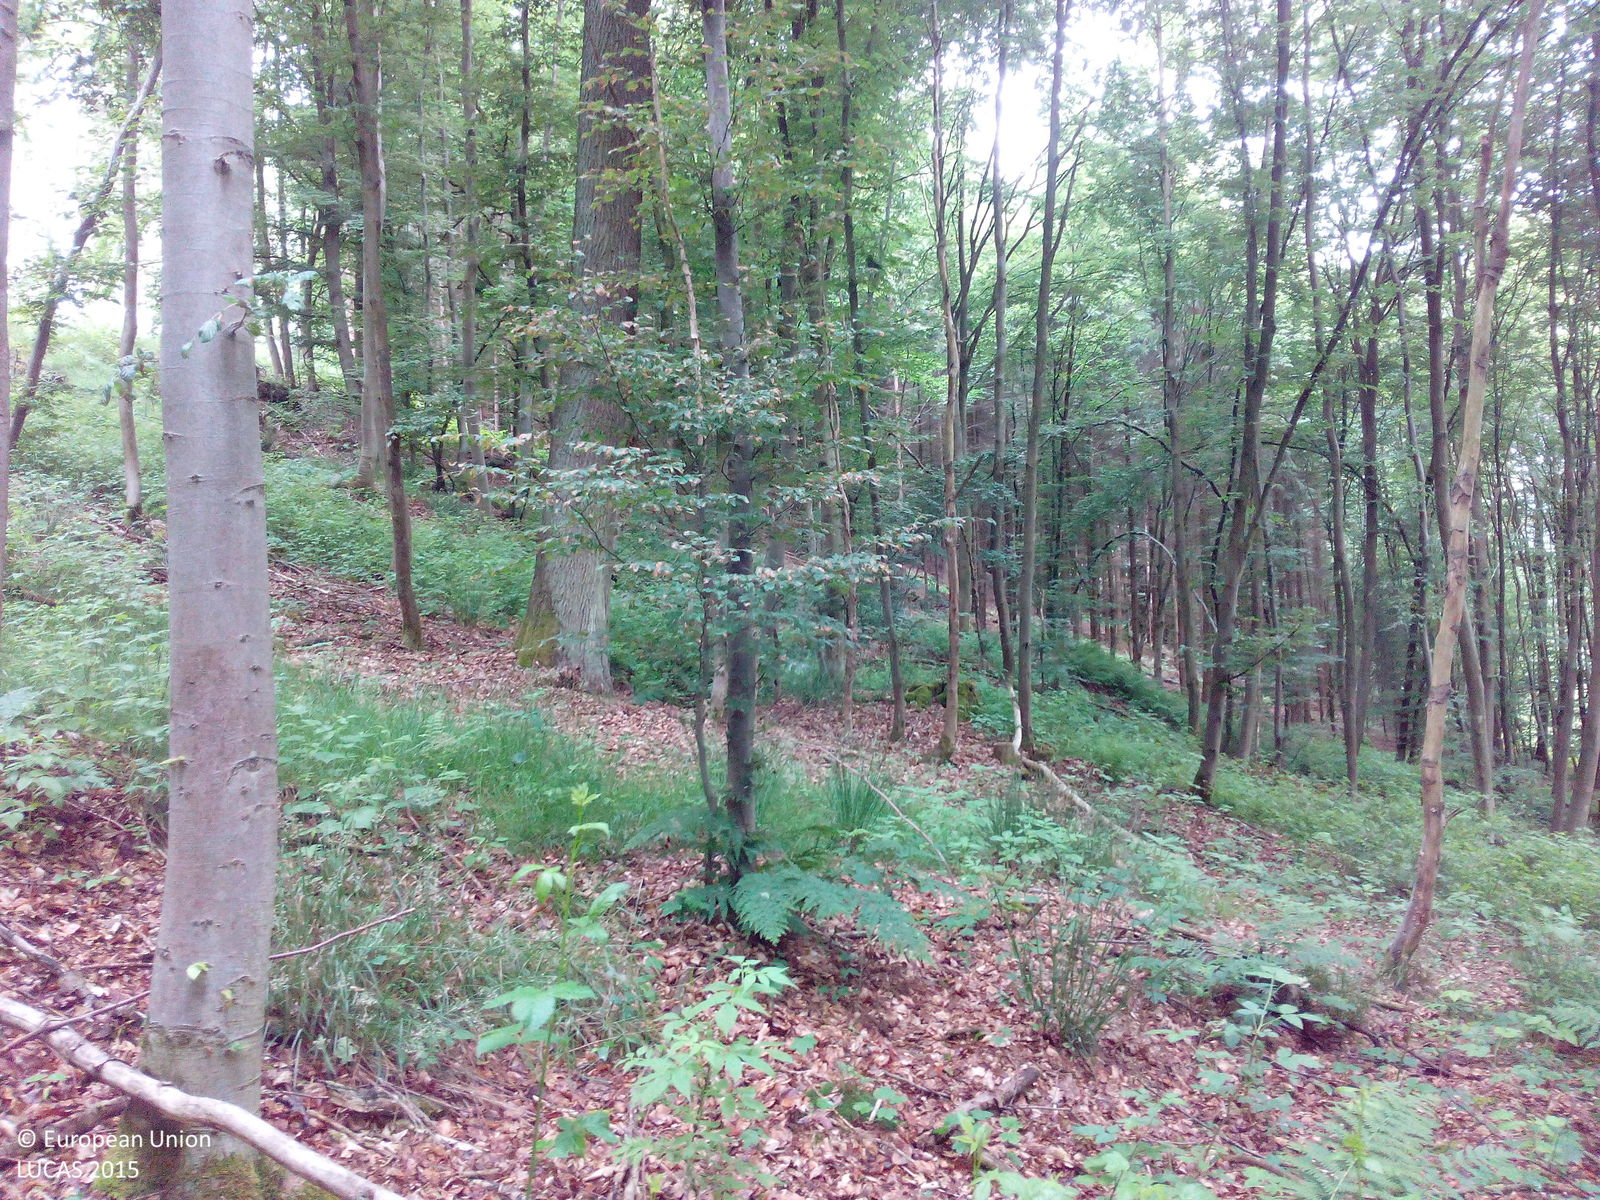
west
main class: Woodland
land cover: Broadleaved woodland
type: beech forest
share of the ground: > 75 %
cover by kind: broadleaved forest trees 85 %, herbaceous plants 10 %, coniferous forest trees 5 %
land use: Forestry
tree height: > 5 m
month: June
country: DE
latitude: 51.6220
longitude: 9.6390
